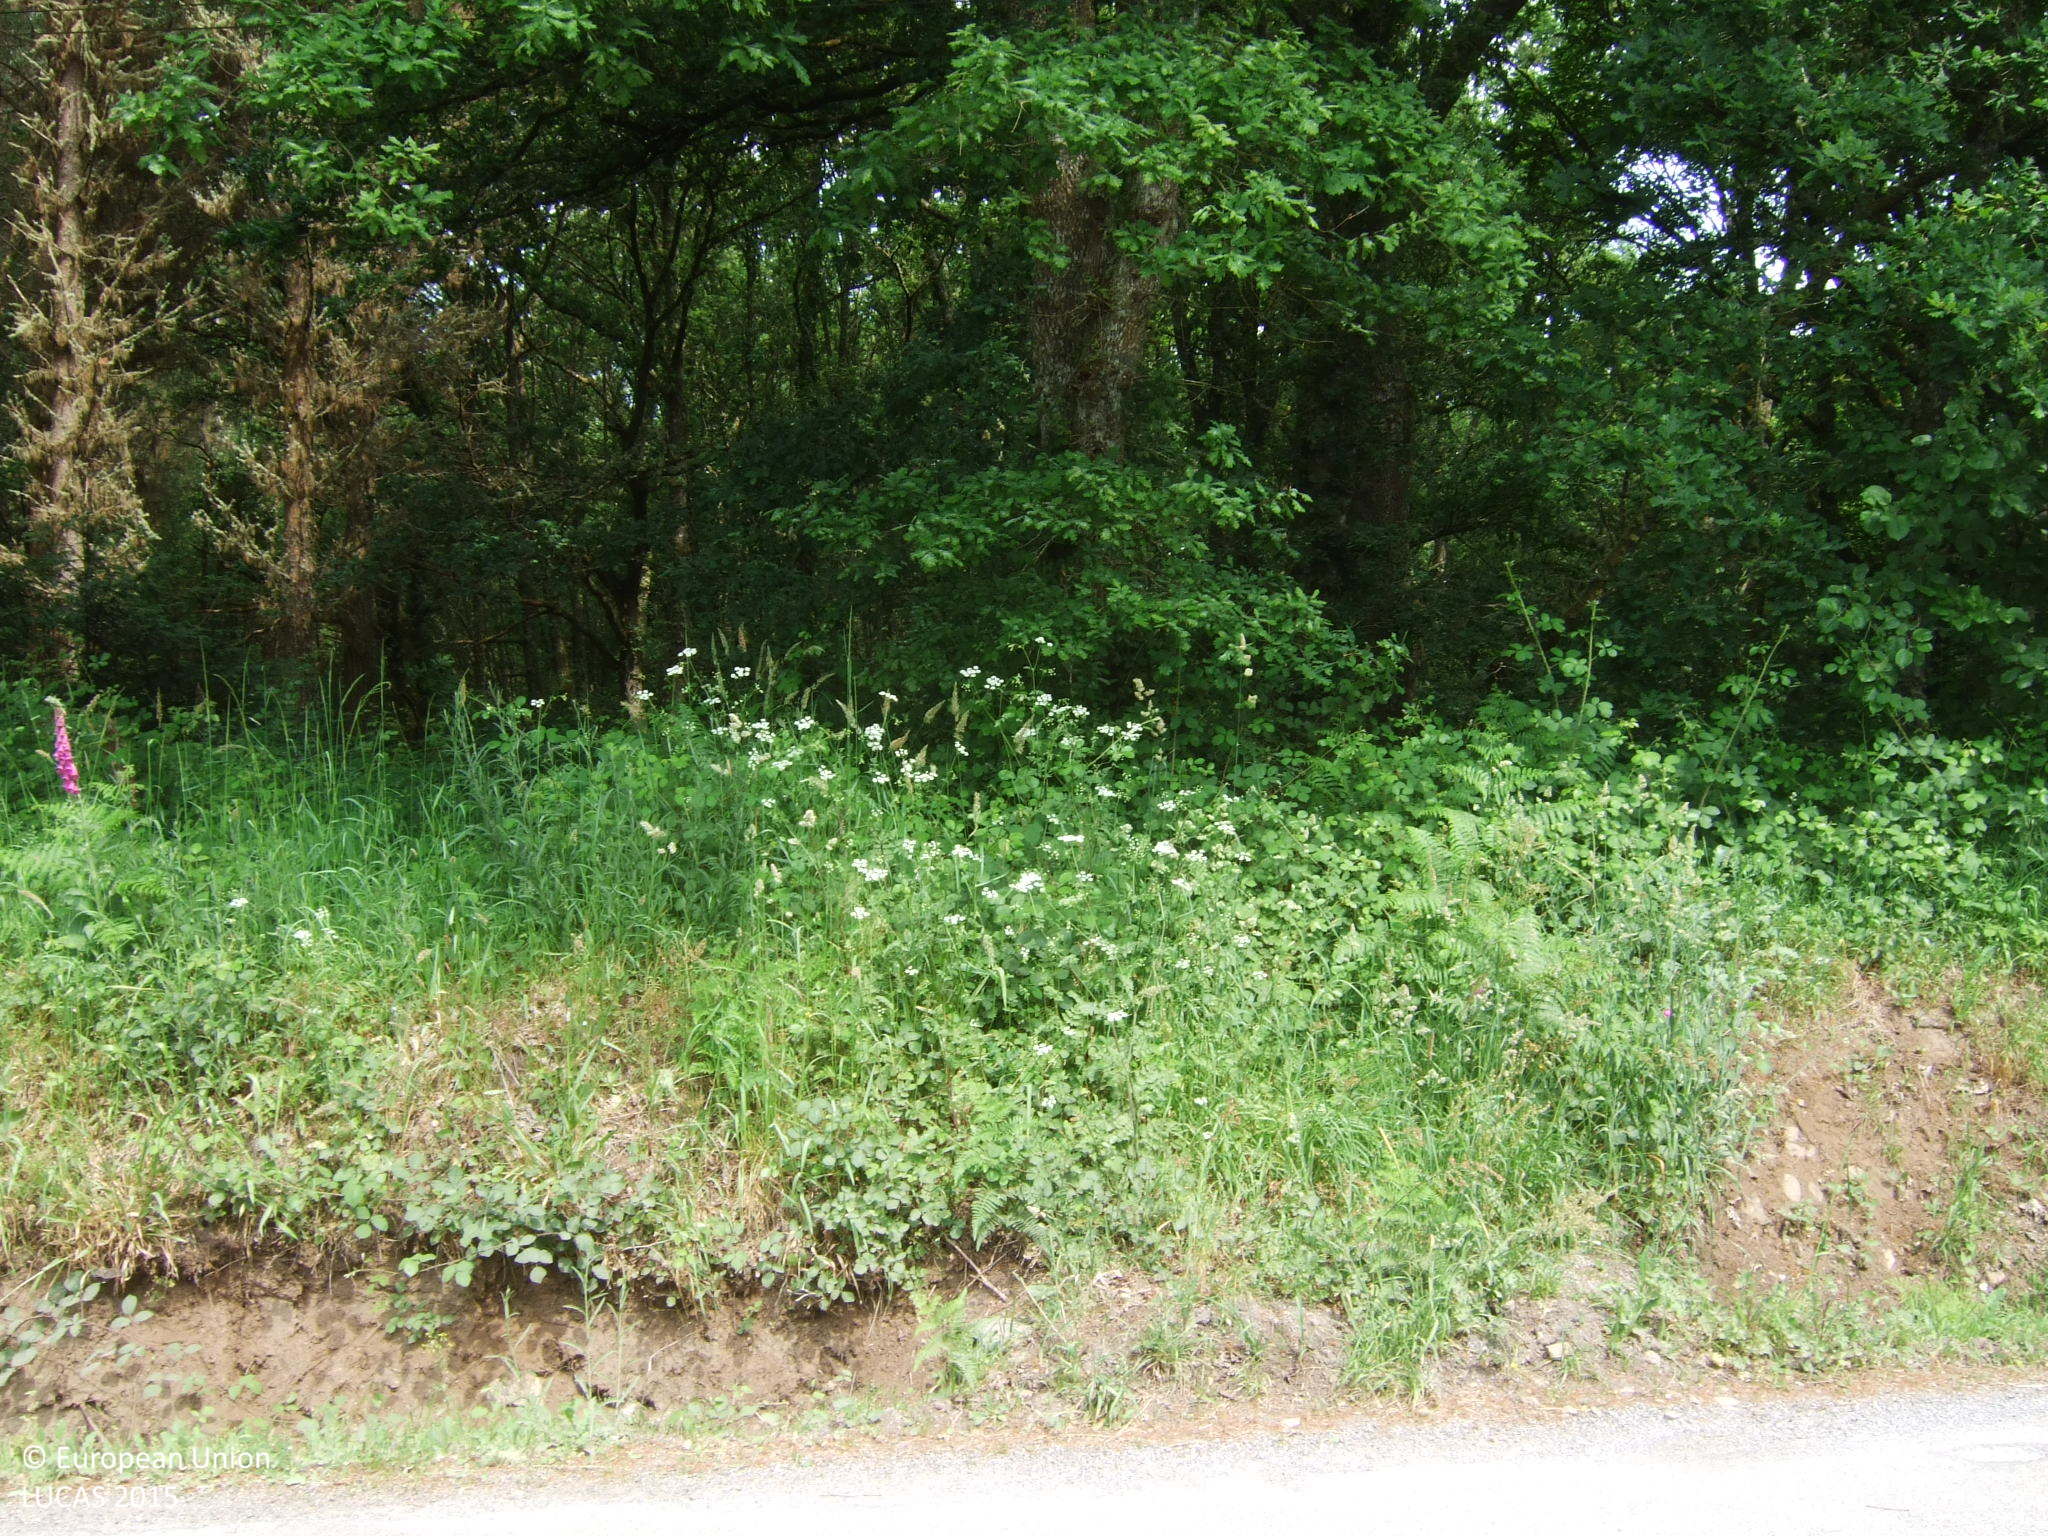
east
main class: Cropland
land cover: Apple fruit
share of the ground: 10 - 25 %
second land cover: Grassland without tree/shrub cover
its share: > 75 %
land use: Kitchen garden
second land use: Residential
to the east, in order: Apple fruit; Grassland without tree/shrub cover; Managed hedges; Paved roads, cycling and walking lanes; Electric lines; Broadleaved woodland
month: June
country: ES
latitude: 43.3329
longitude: -7.6847
